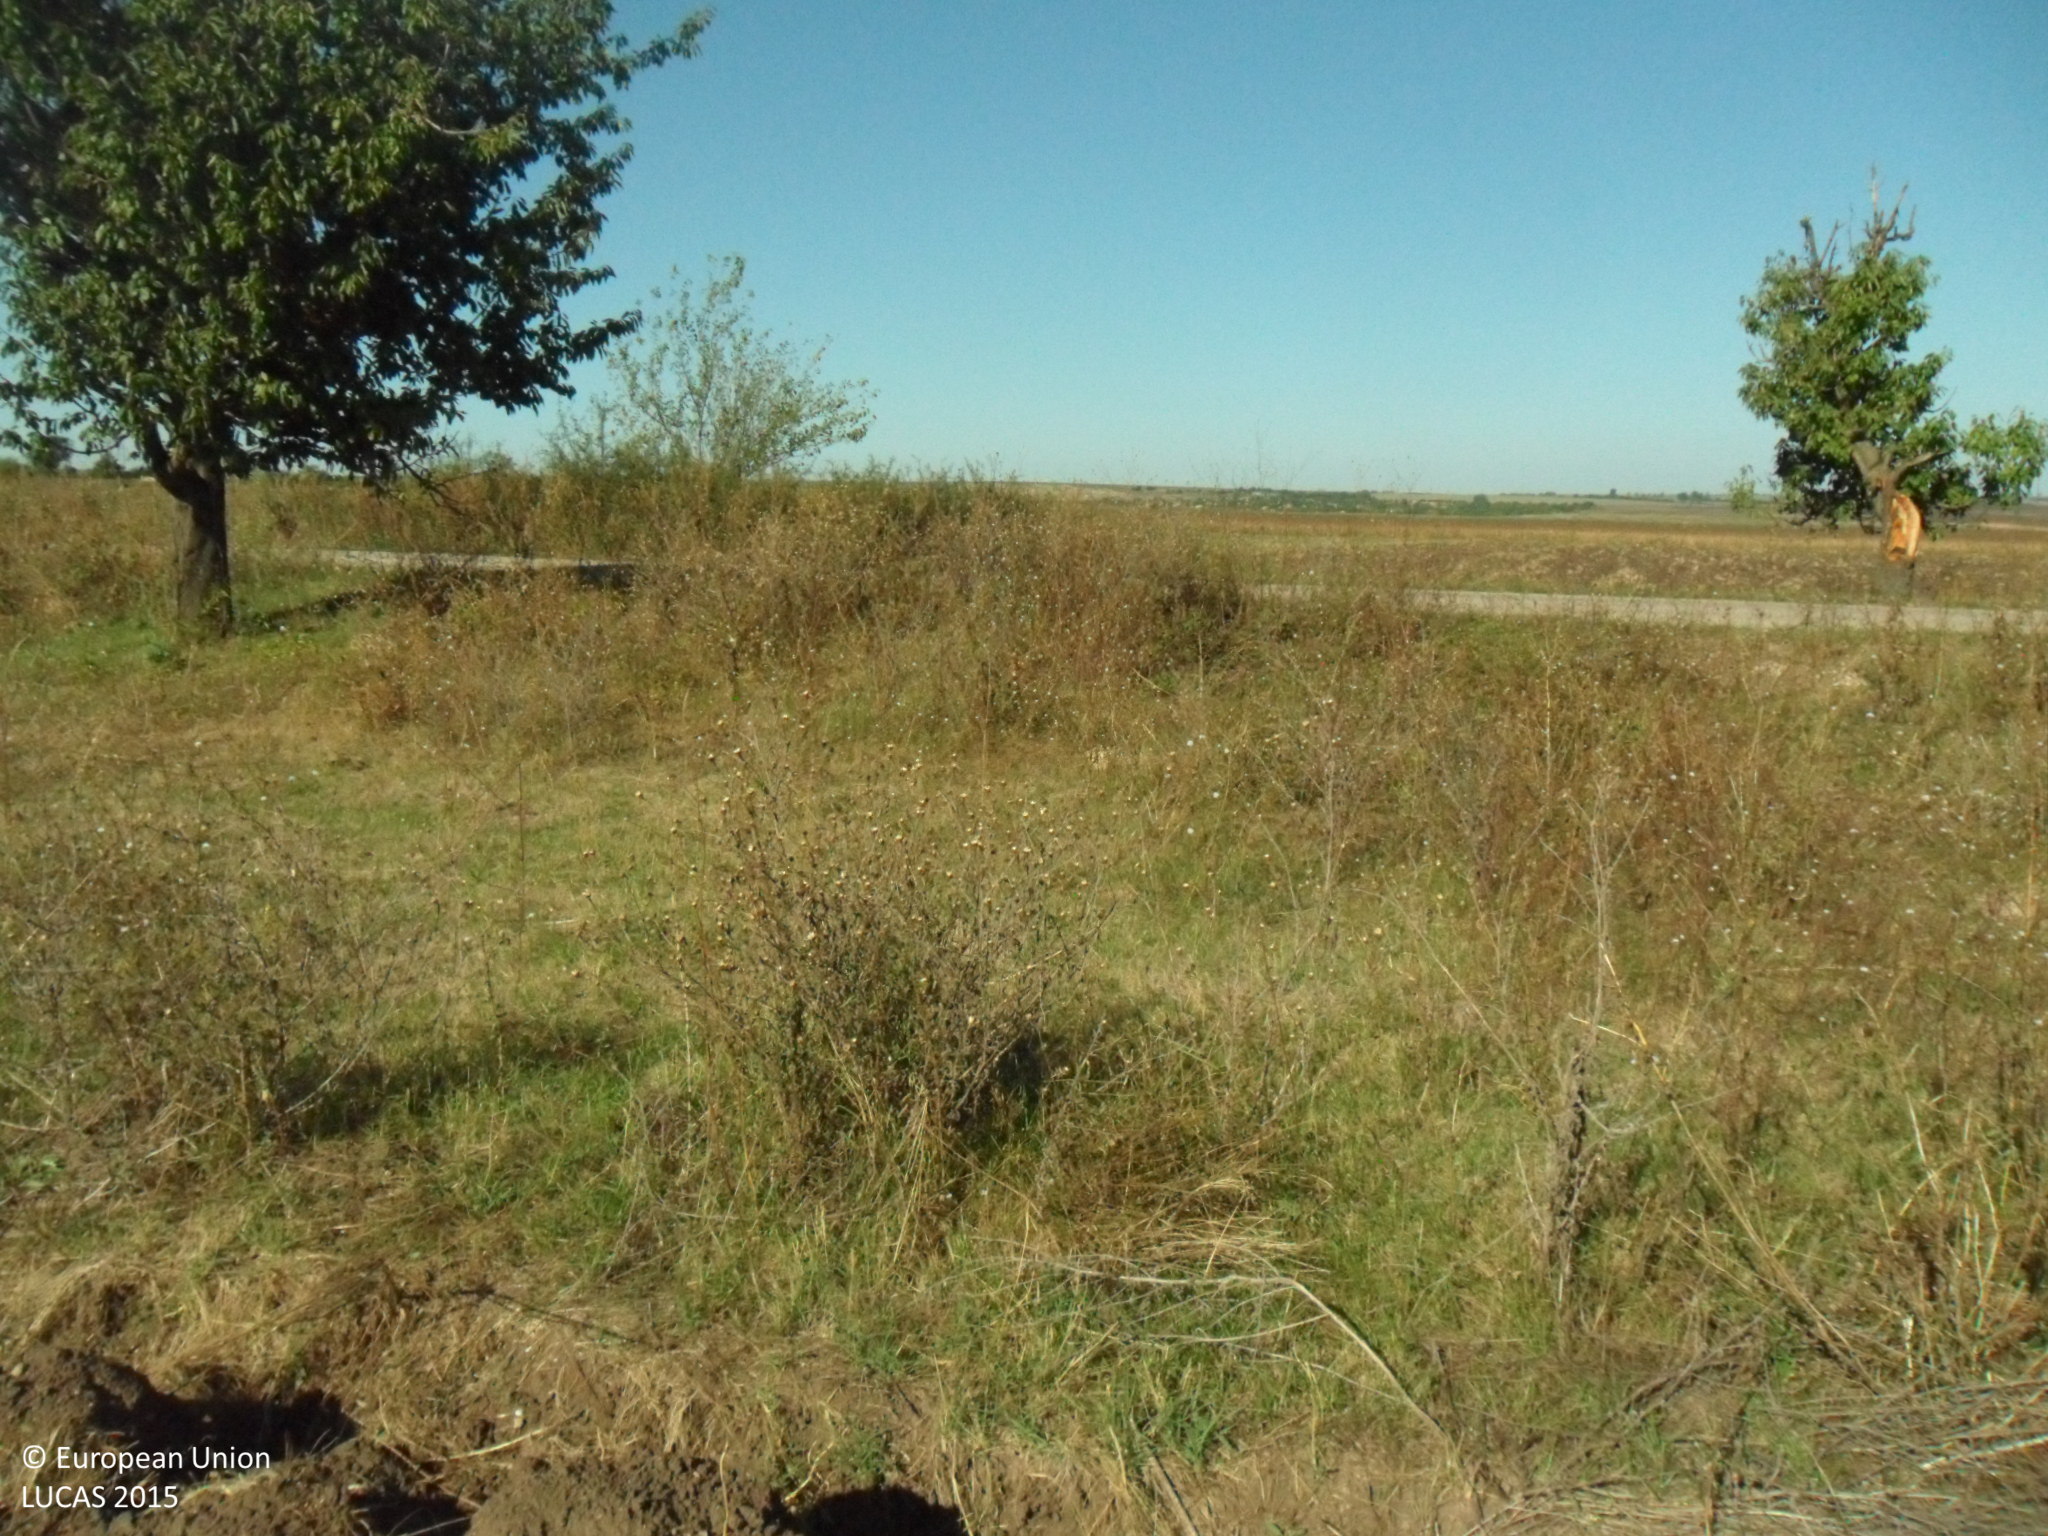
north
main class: Grassland
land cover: Spontaneously vegetated surfaces
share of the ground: > 75 %
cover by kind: herbaceous plants 95 %, shrubs 5 %
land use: Agriculture (excluding fallow land and kitchen gardens)
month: September
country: BG
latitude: 43.1896
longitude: 27.2356
